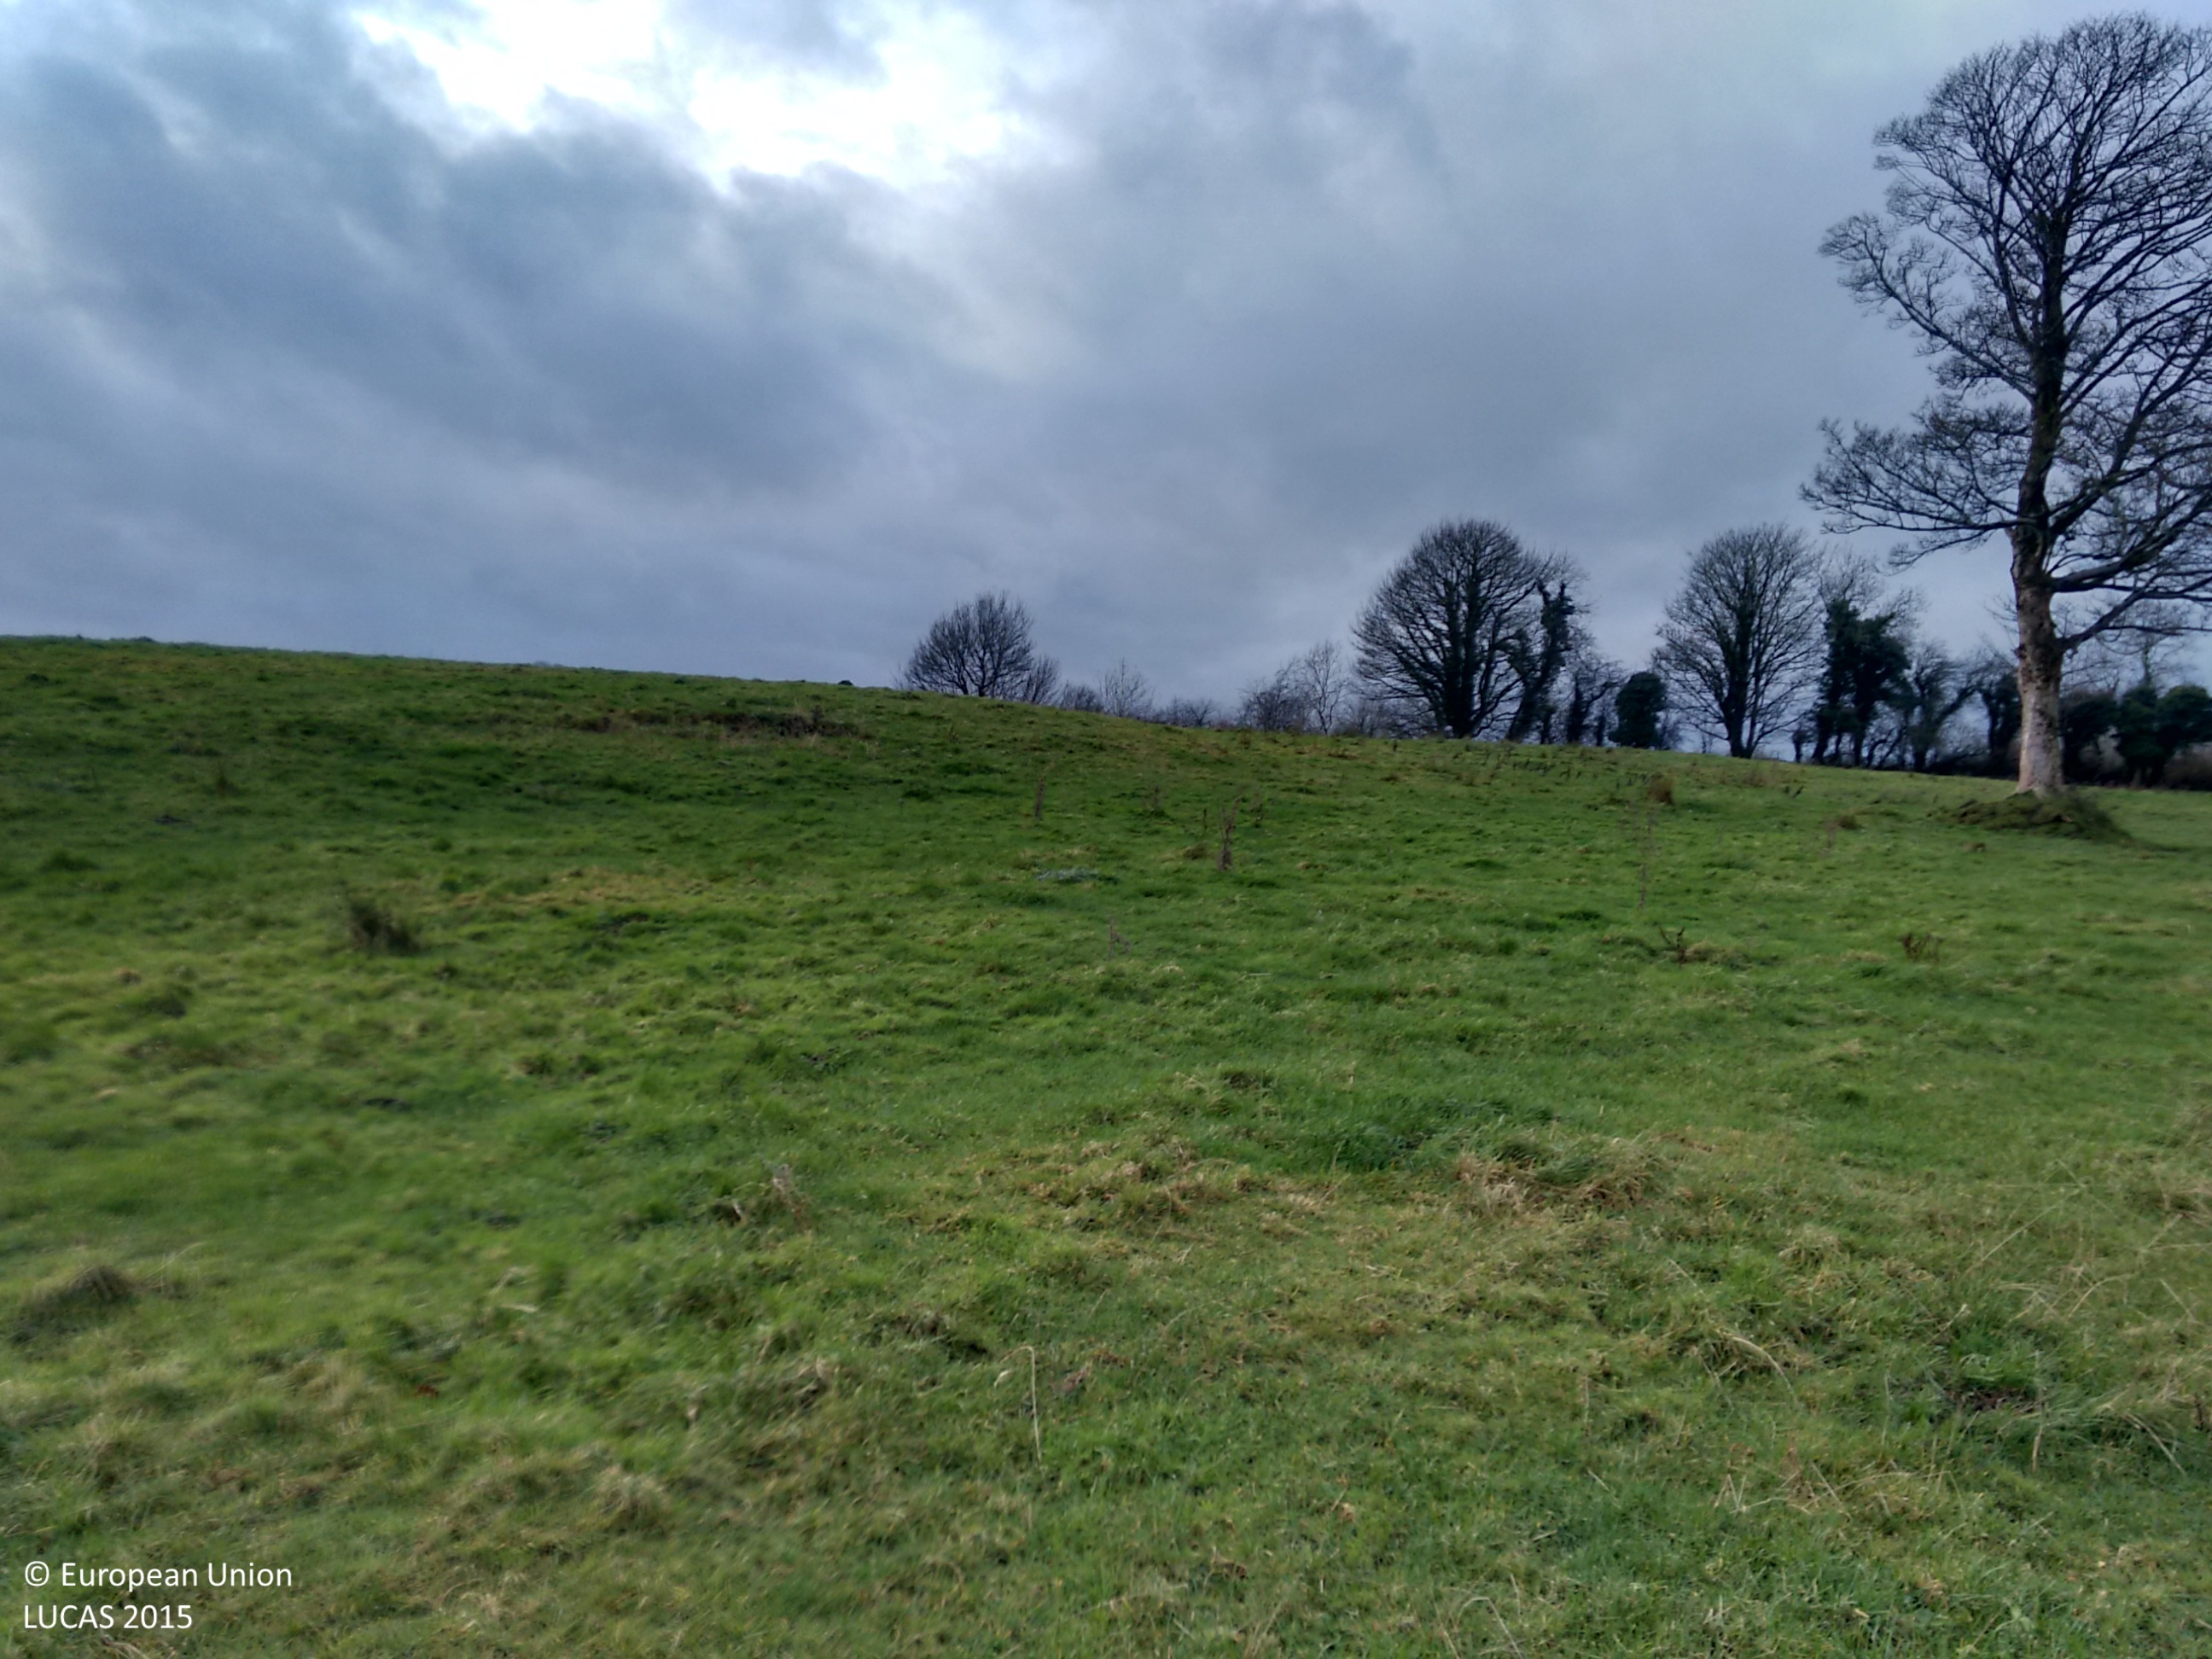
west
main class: Grassland
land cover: Grassland without tree/shrub cover
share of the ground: > 75 %
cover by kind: herbaceous plants 100 %
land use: Agriculture (excluding fallow land and kitchen gardens)
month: December
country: IE
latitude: 53.9690
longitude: -6.8910
